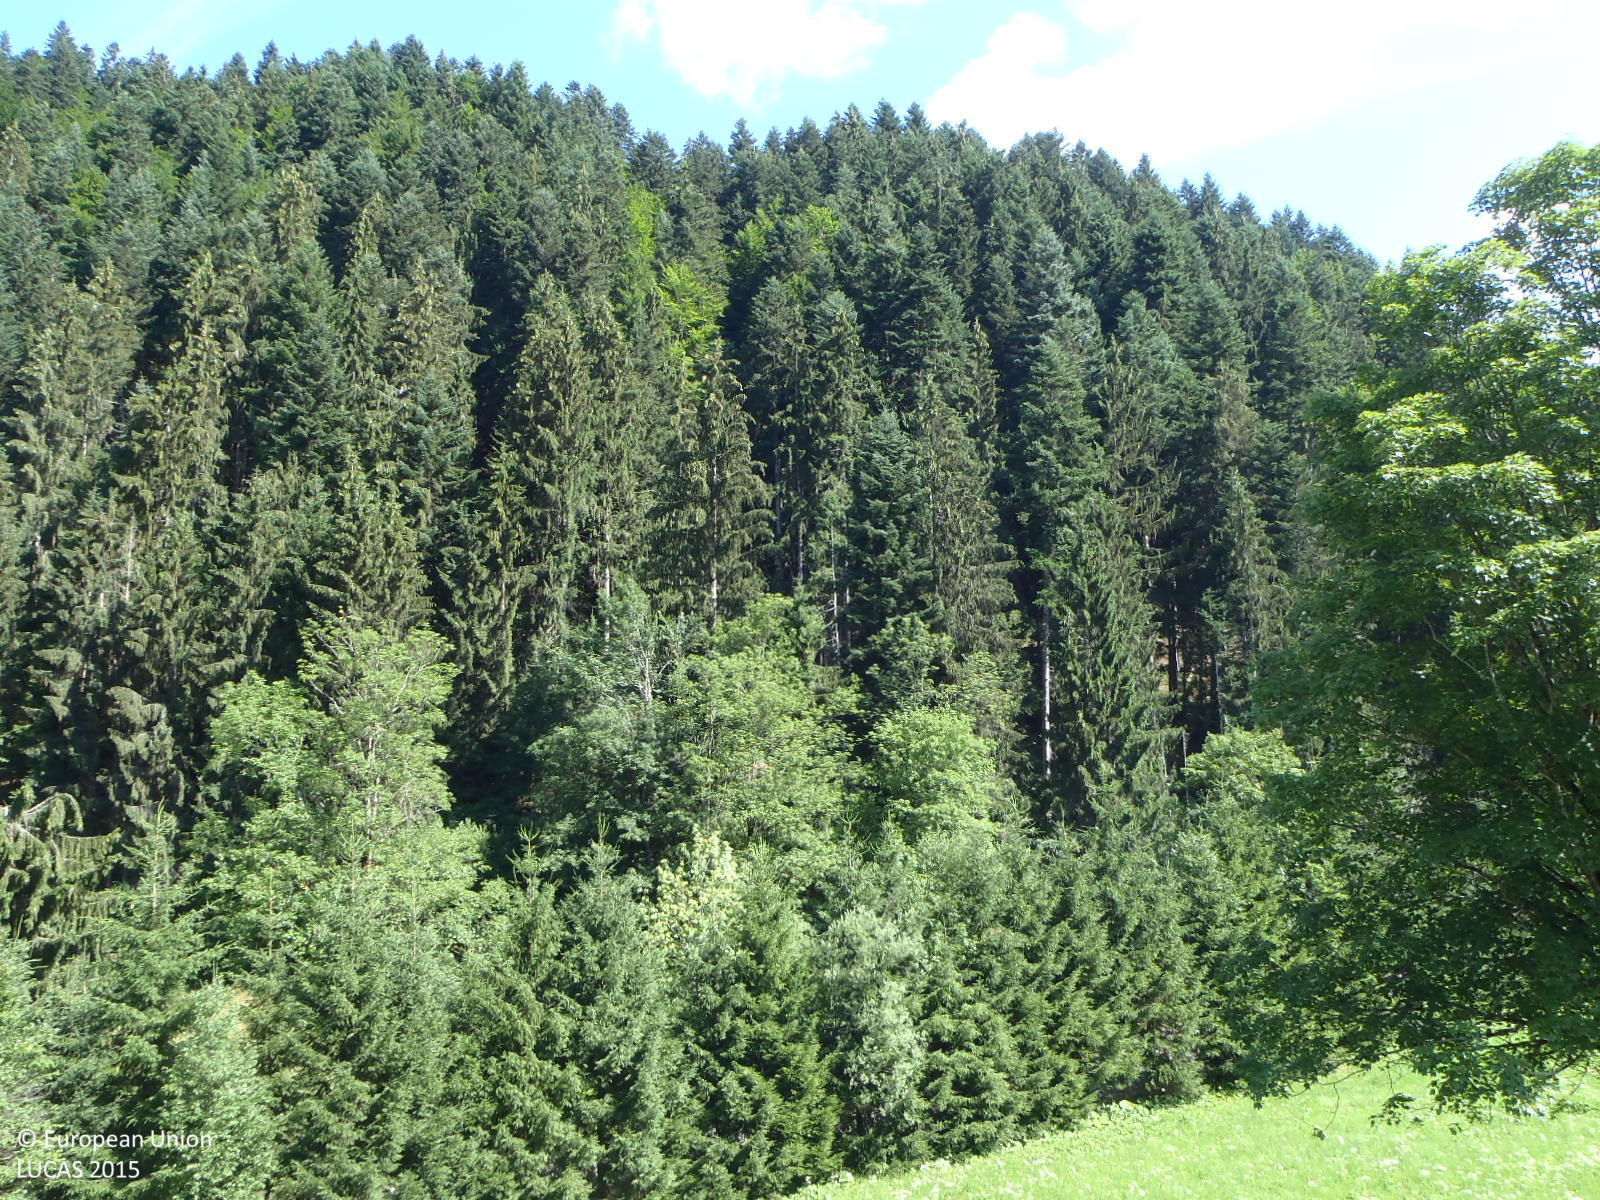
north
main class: Grassland
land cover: Grassland without tree/shrub cover
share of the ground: > 75 %
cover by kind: herbaceous plants 100 %
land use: Agriculture (excluding fallow land and kitchen gardens)
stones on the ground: < 10 %
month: July
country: AT
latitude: 47.5171
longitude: 12.2161
